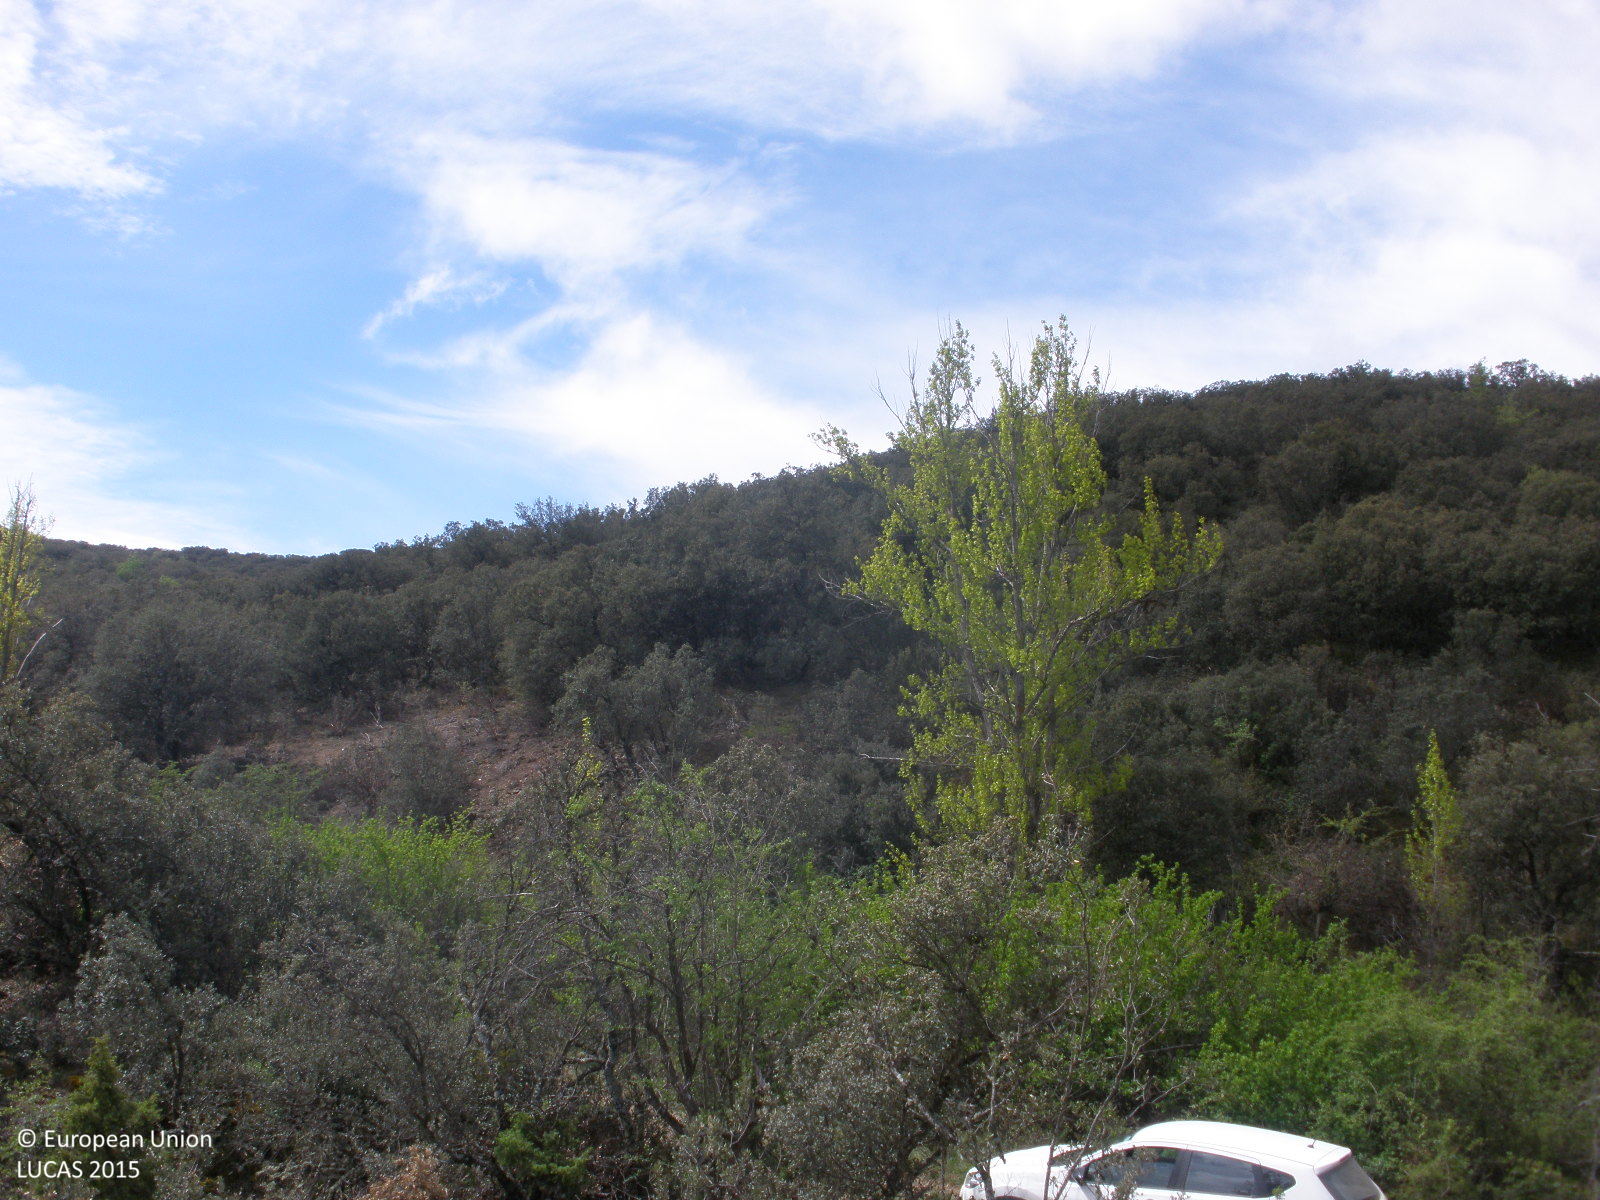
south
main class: Woodland
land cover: Broadleaved woodland
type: broadleaved evergreen forest
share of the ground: > 75 %
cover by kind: broadleaved forest trees 70 %, shrubs 30 %
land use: Semi-natural and natural areas not in use
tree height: < 5 m
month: May
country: ES
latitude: 40.9339
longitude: -0.9060
